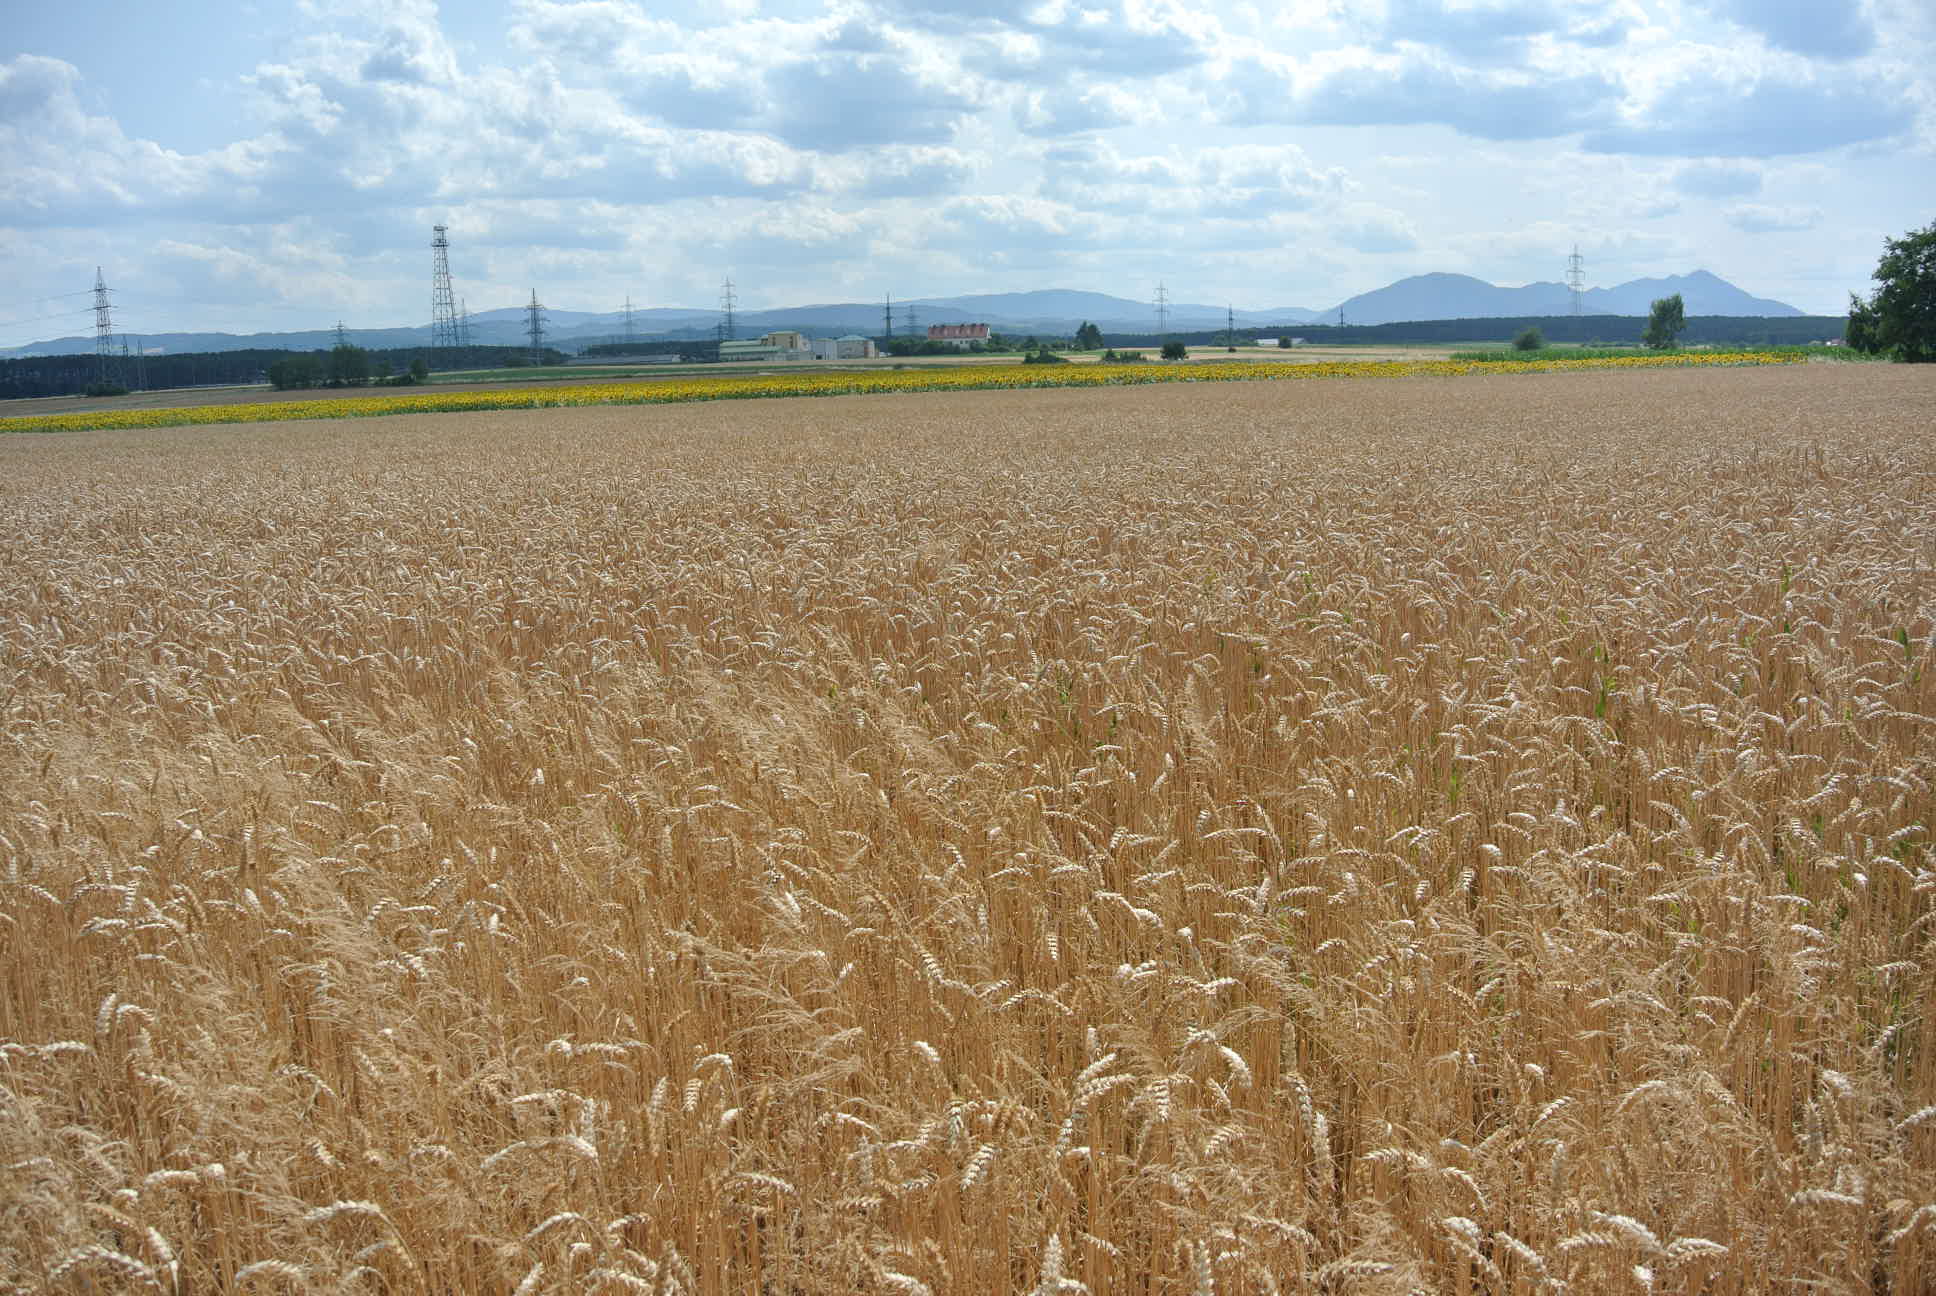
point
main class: Cropland
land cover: Common wheat
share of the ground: > 75 %
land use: Agriculture (excluding fallow land and kitchen gardens)
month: July
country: AT
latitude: 47.7135
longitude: 16.0677
